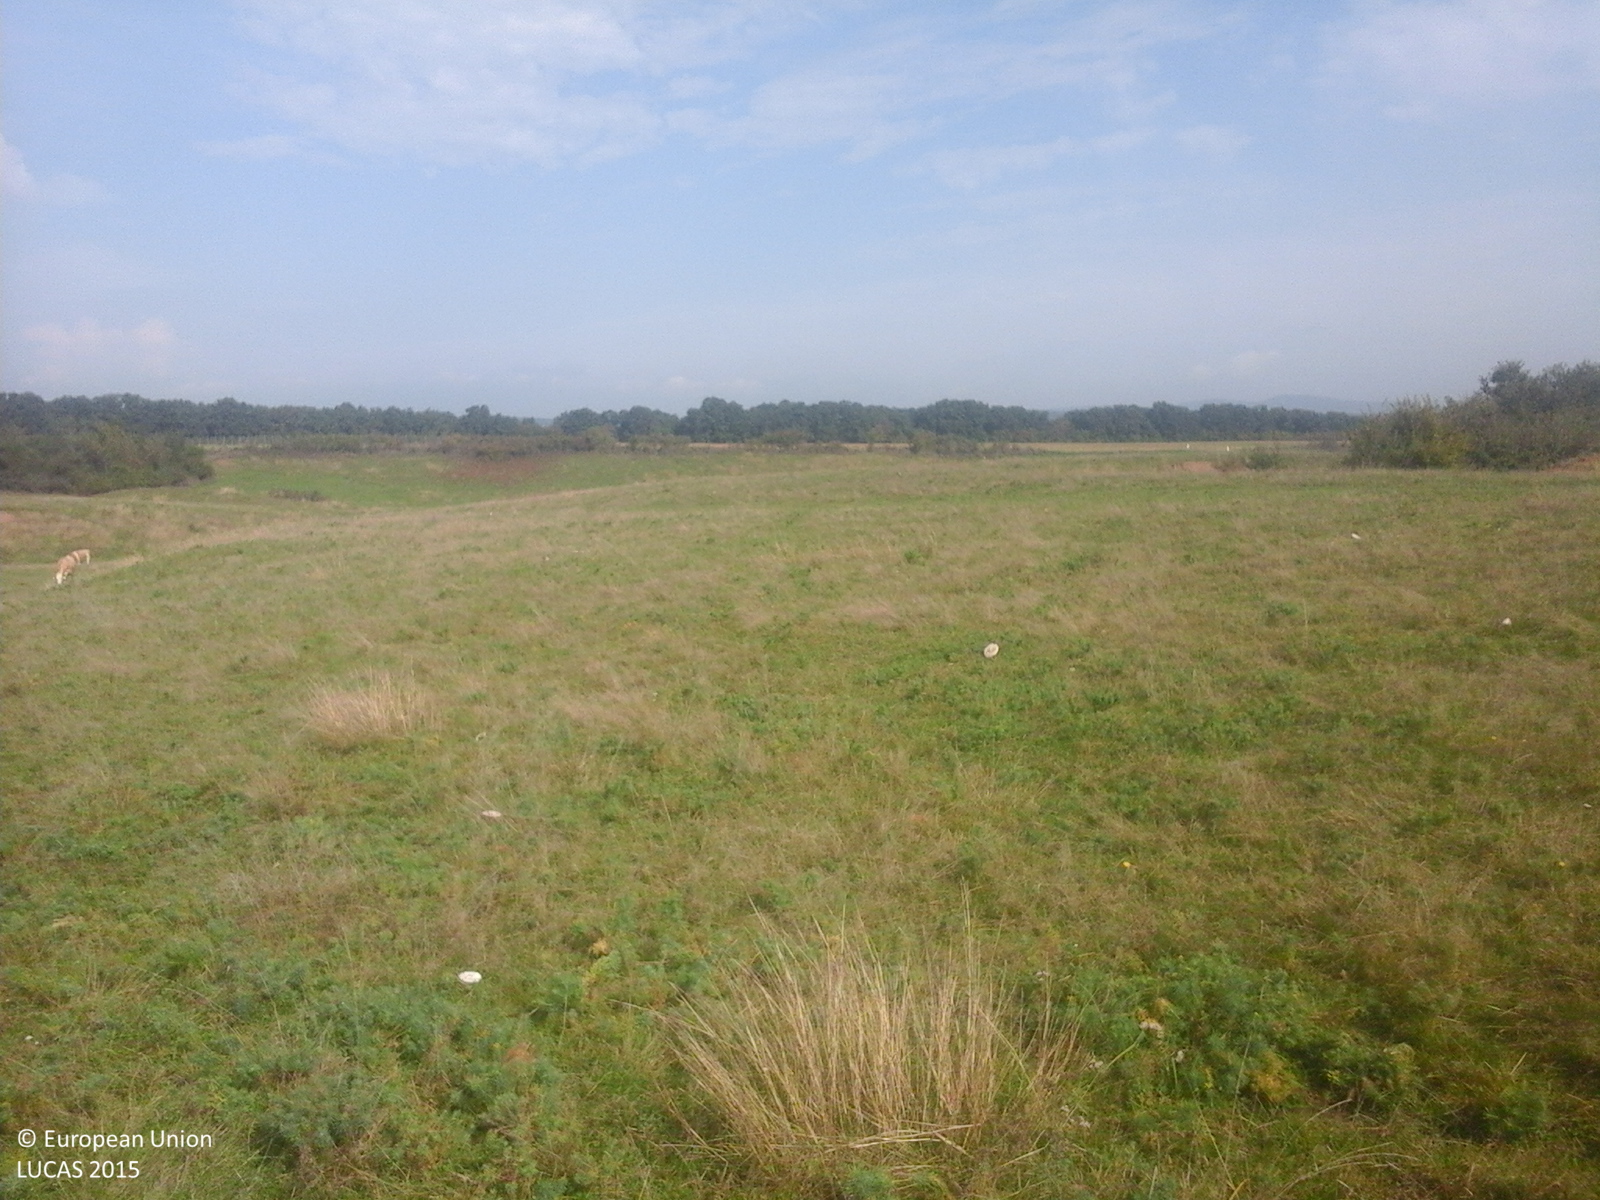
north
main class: Grassland
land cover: Grassland without tree/shrub cover
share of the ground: > 75 %
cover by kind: herbaceous plants 100 %
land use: Agriculture (excluding fallow land and kitchen gardens)
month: October
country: RO
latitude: 46.3091
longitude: 23.6646
